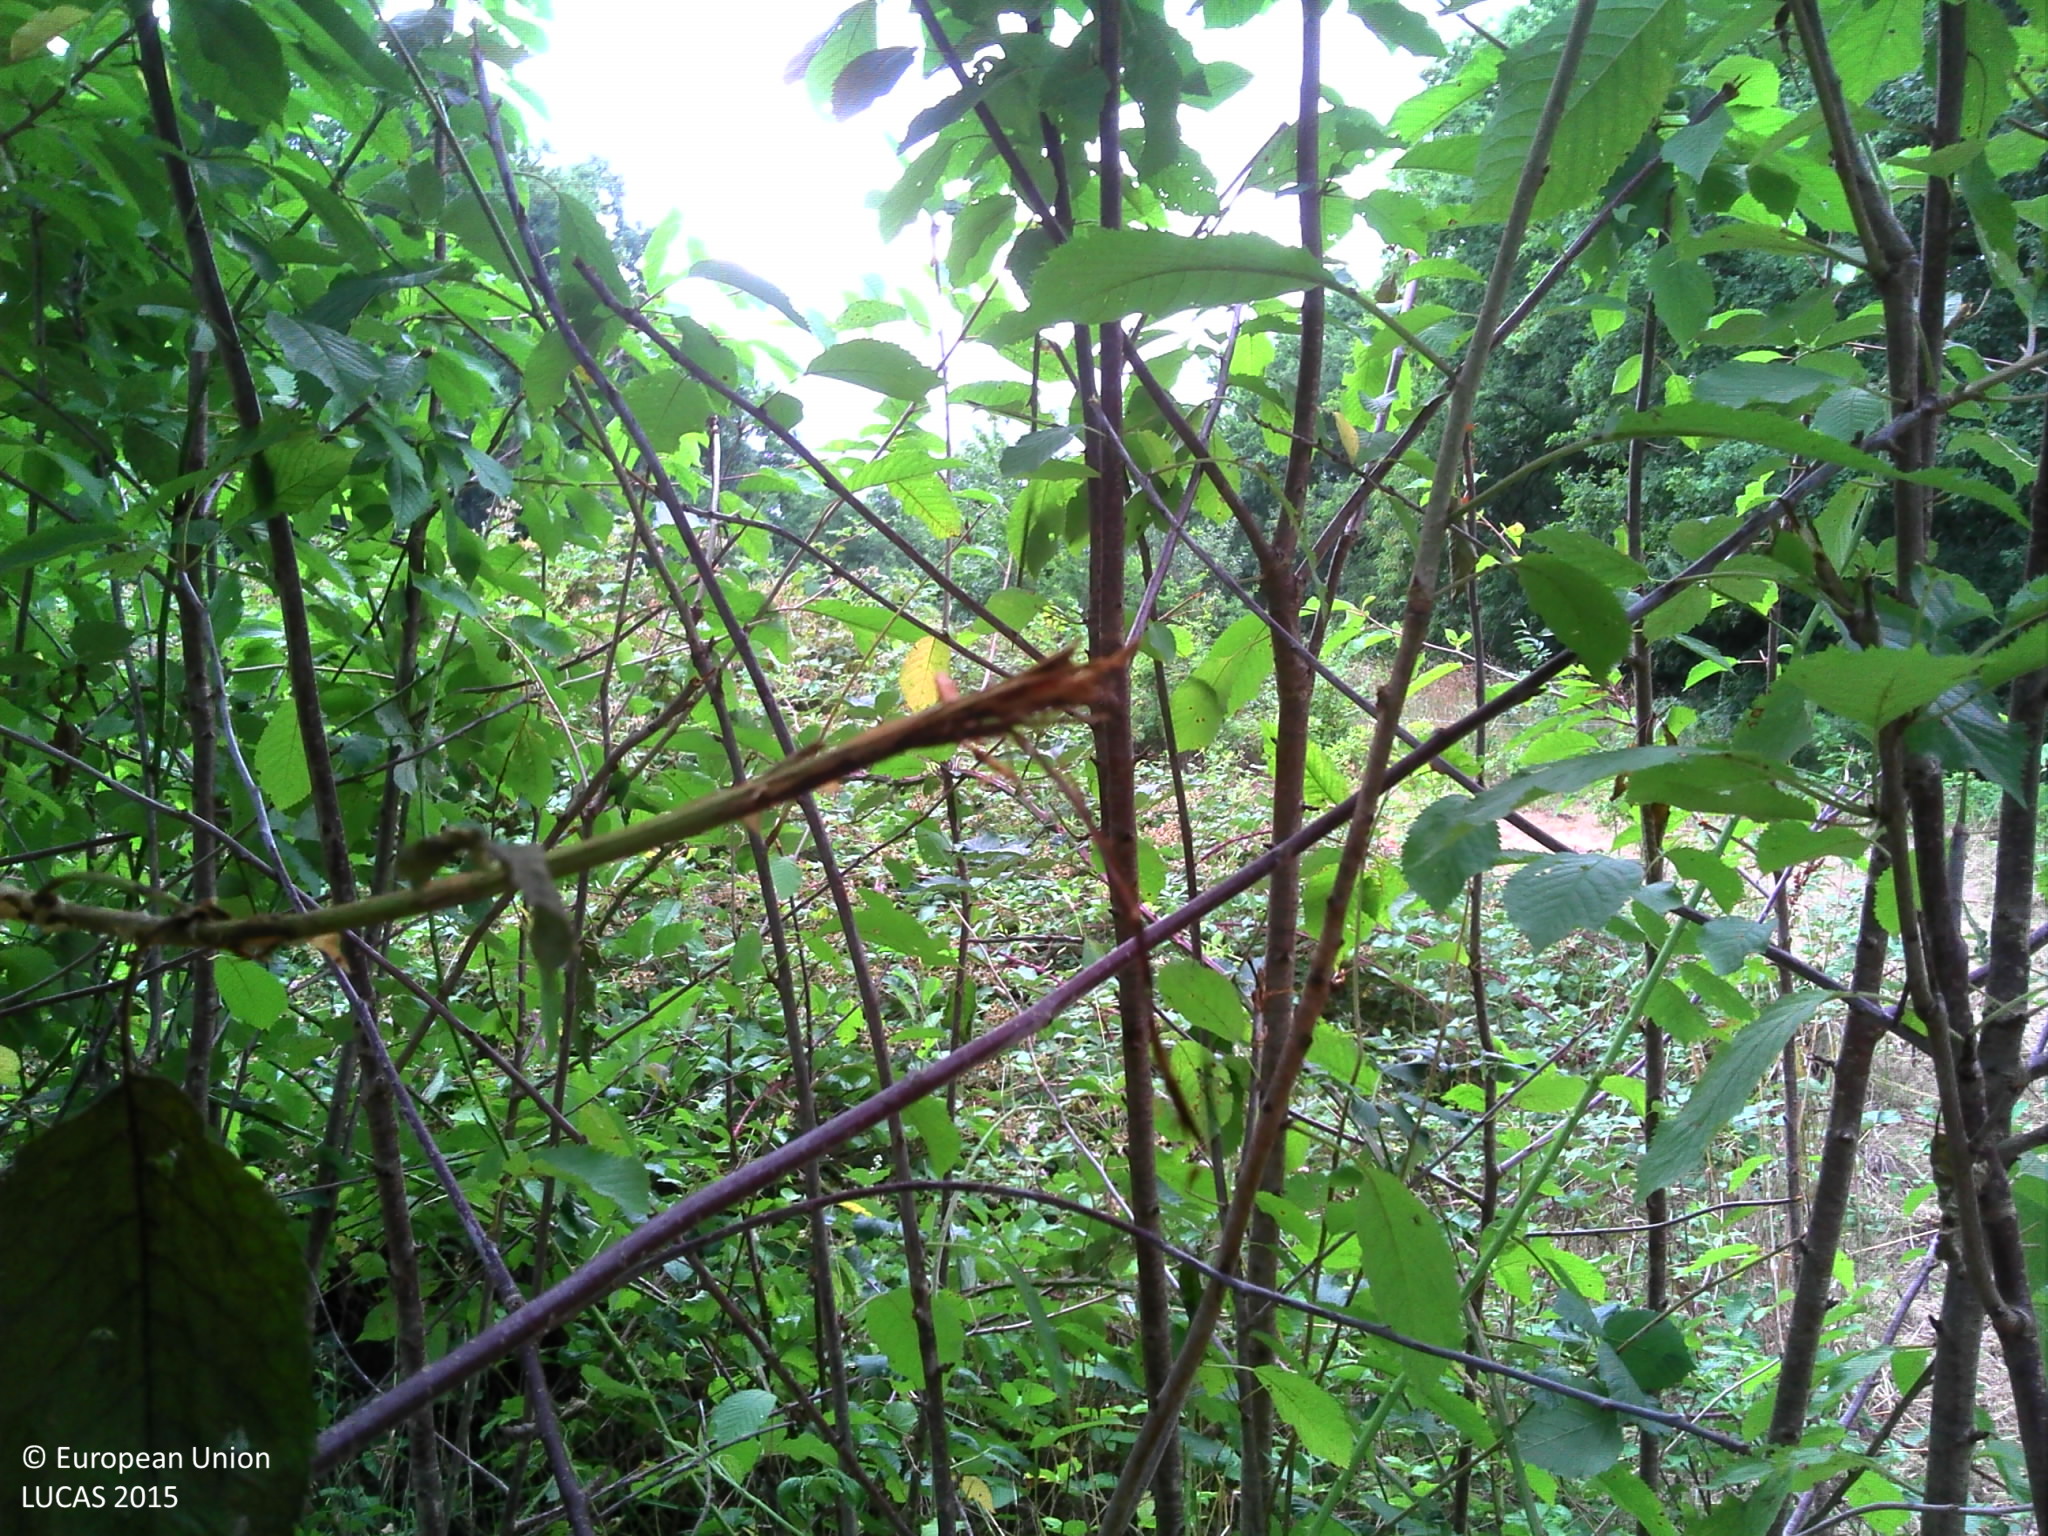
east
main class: Shrubland
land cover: Shrubland with sparse tree cover
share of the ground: > 75 %
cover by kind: shrubs 50 %, herbaceous plants 45 %, broadleaved forest trees 5 %
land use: Agriculture (excluding fallow land and kitchen gardens)
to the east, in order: Shrubland with sparse tree cover; Fences; Shrubland with sparse tree cover; Fences; Broadleaved woodland; Spontaneously vegetated surfaces; Inland fresh running water
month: July
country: FR
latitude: 47.5329
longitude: -1.9645
